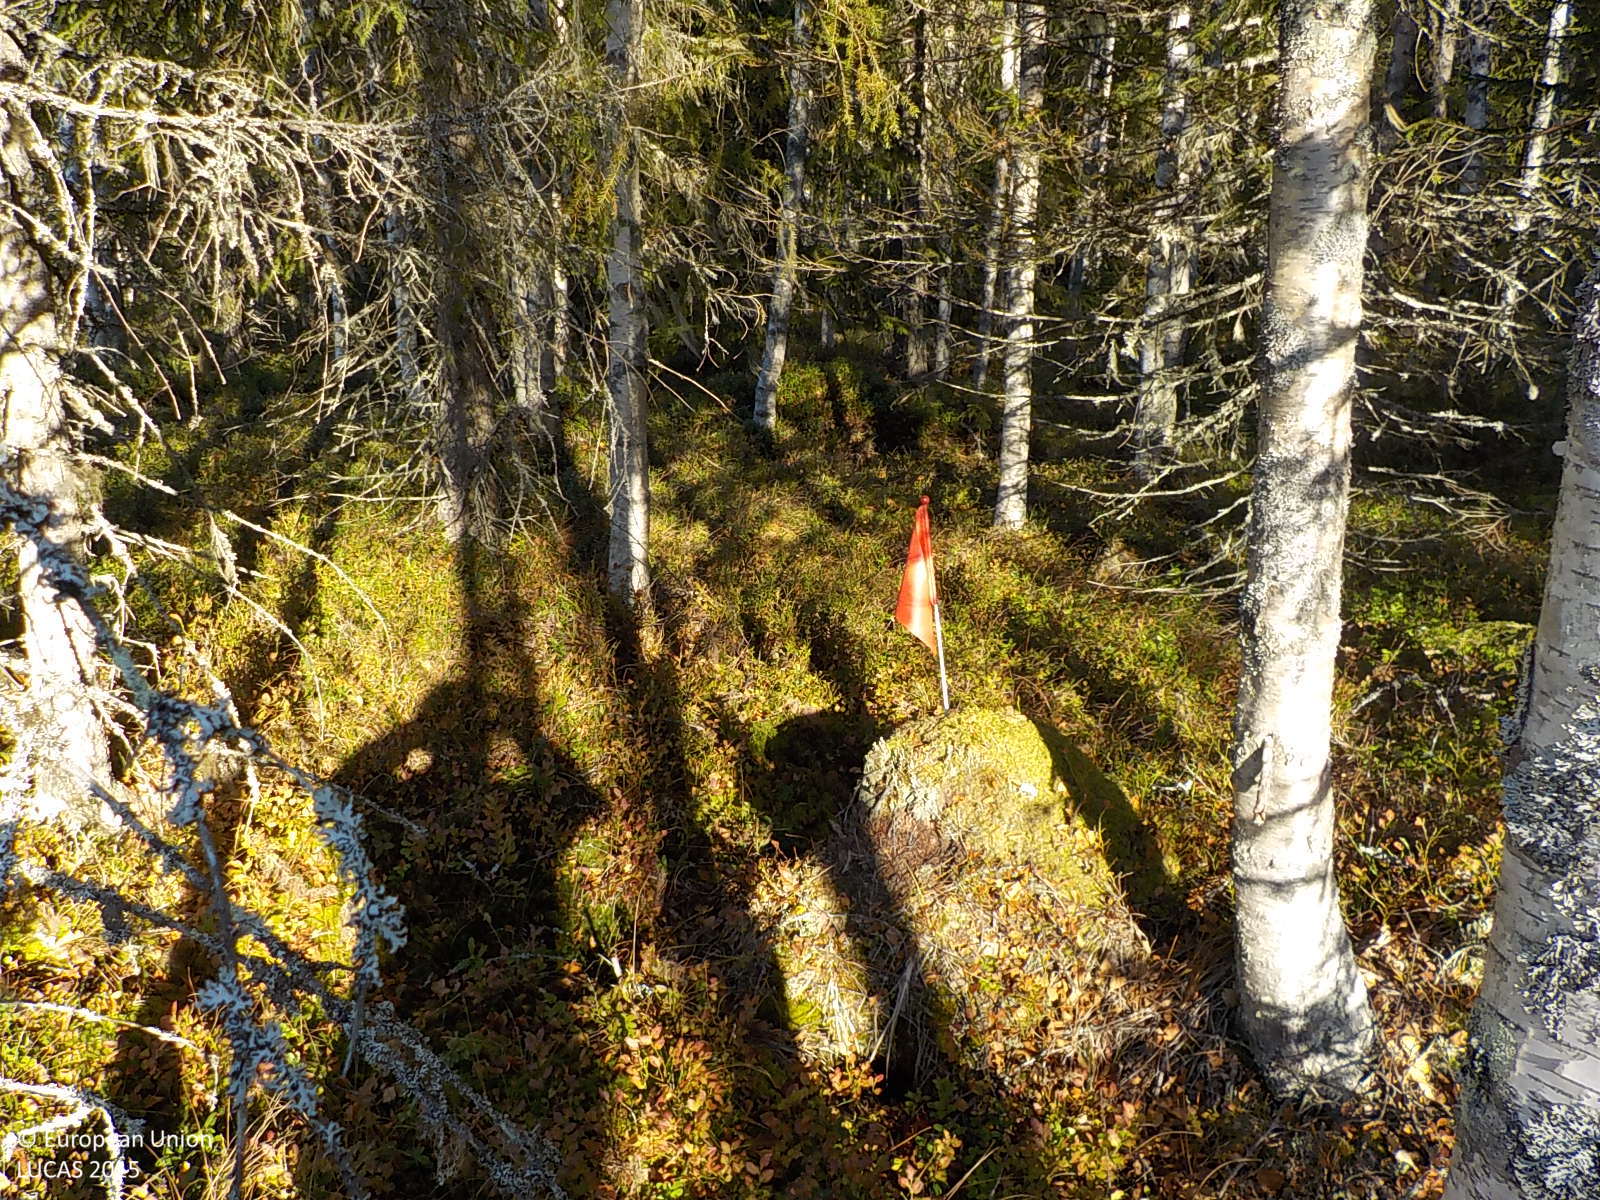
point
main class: Woodland
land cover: Spruce dominated mixed woodland
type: boreal forest
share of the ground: > 75 %
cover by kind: coniferous forest trees 50 %, broadleaved forest trees 45 %, shrubs 5 %
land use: Forestry
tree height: > 5 m
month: October
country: SE
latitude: 63.2858
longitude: 18.0515
